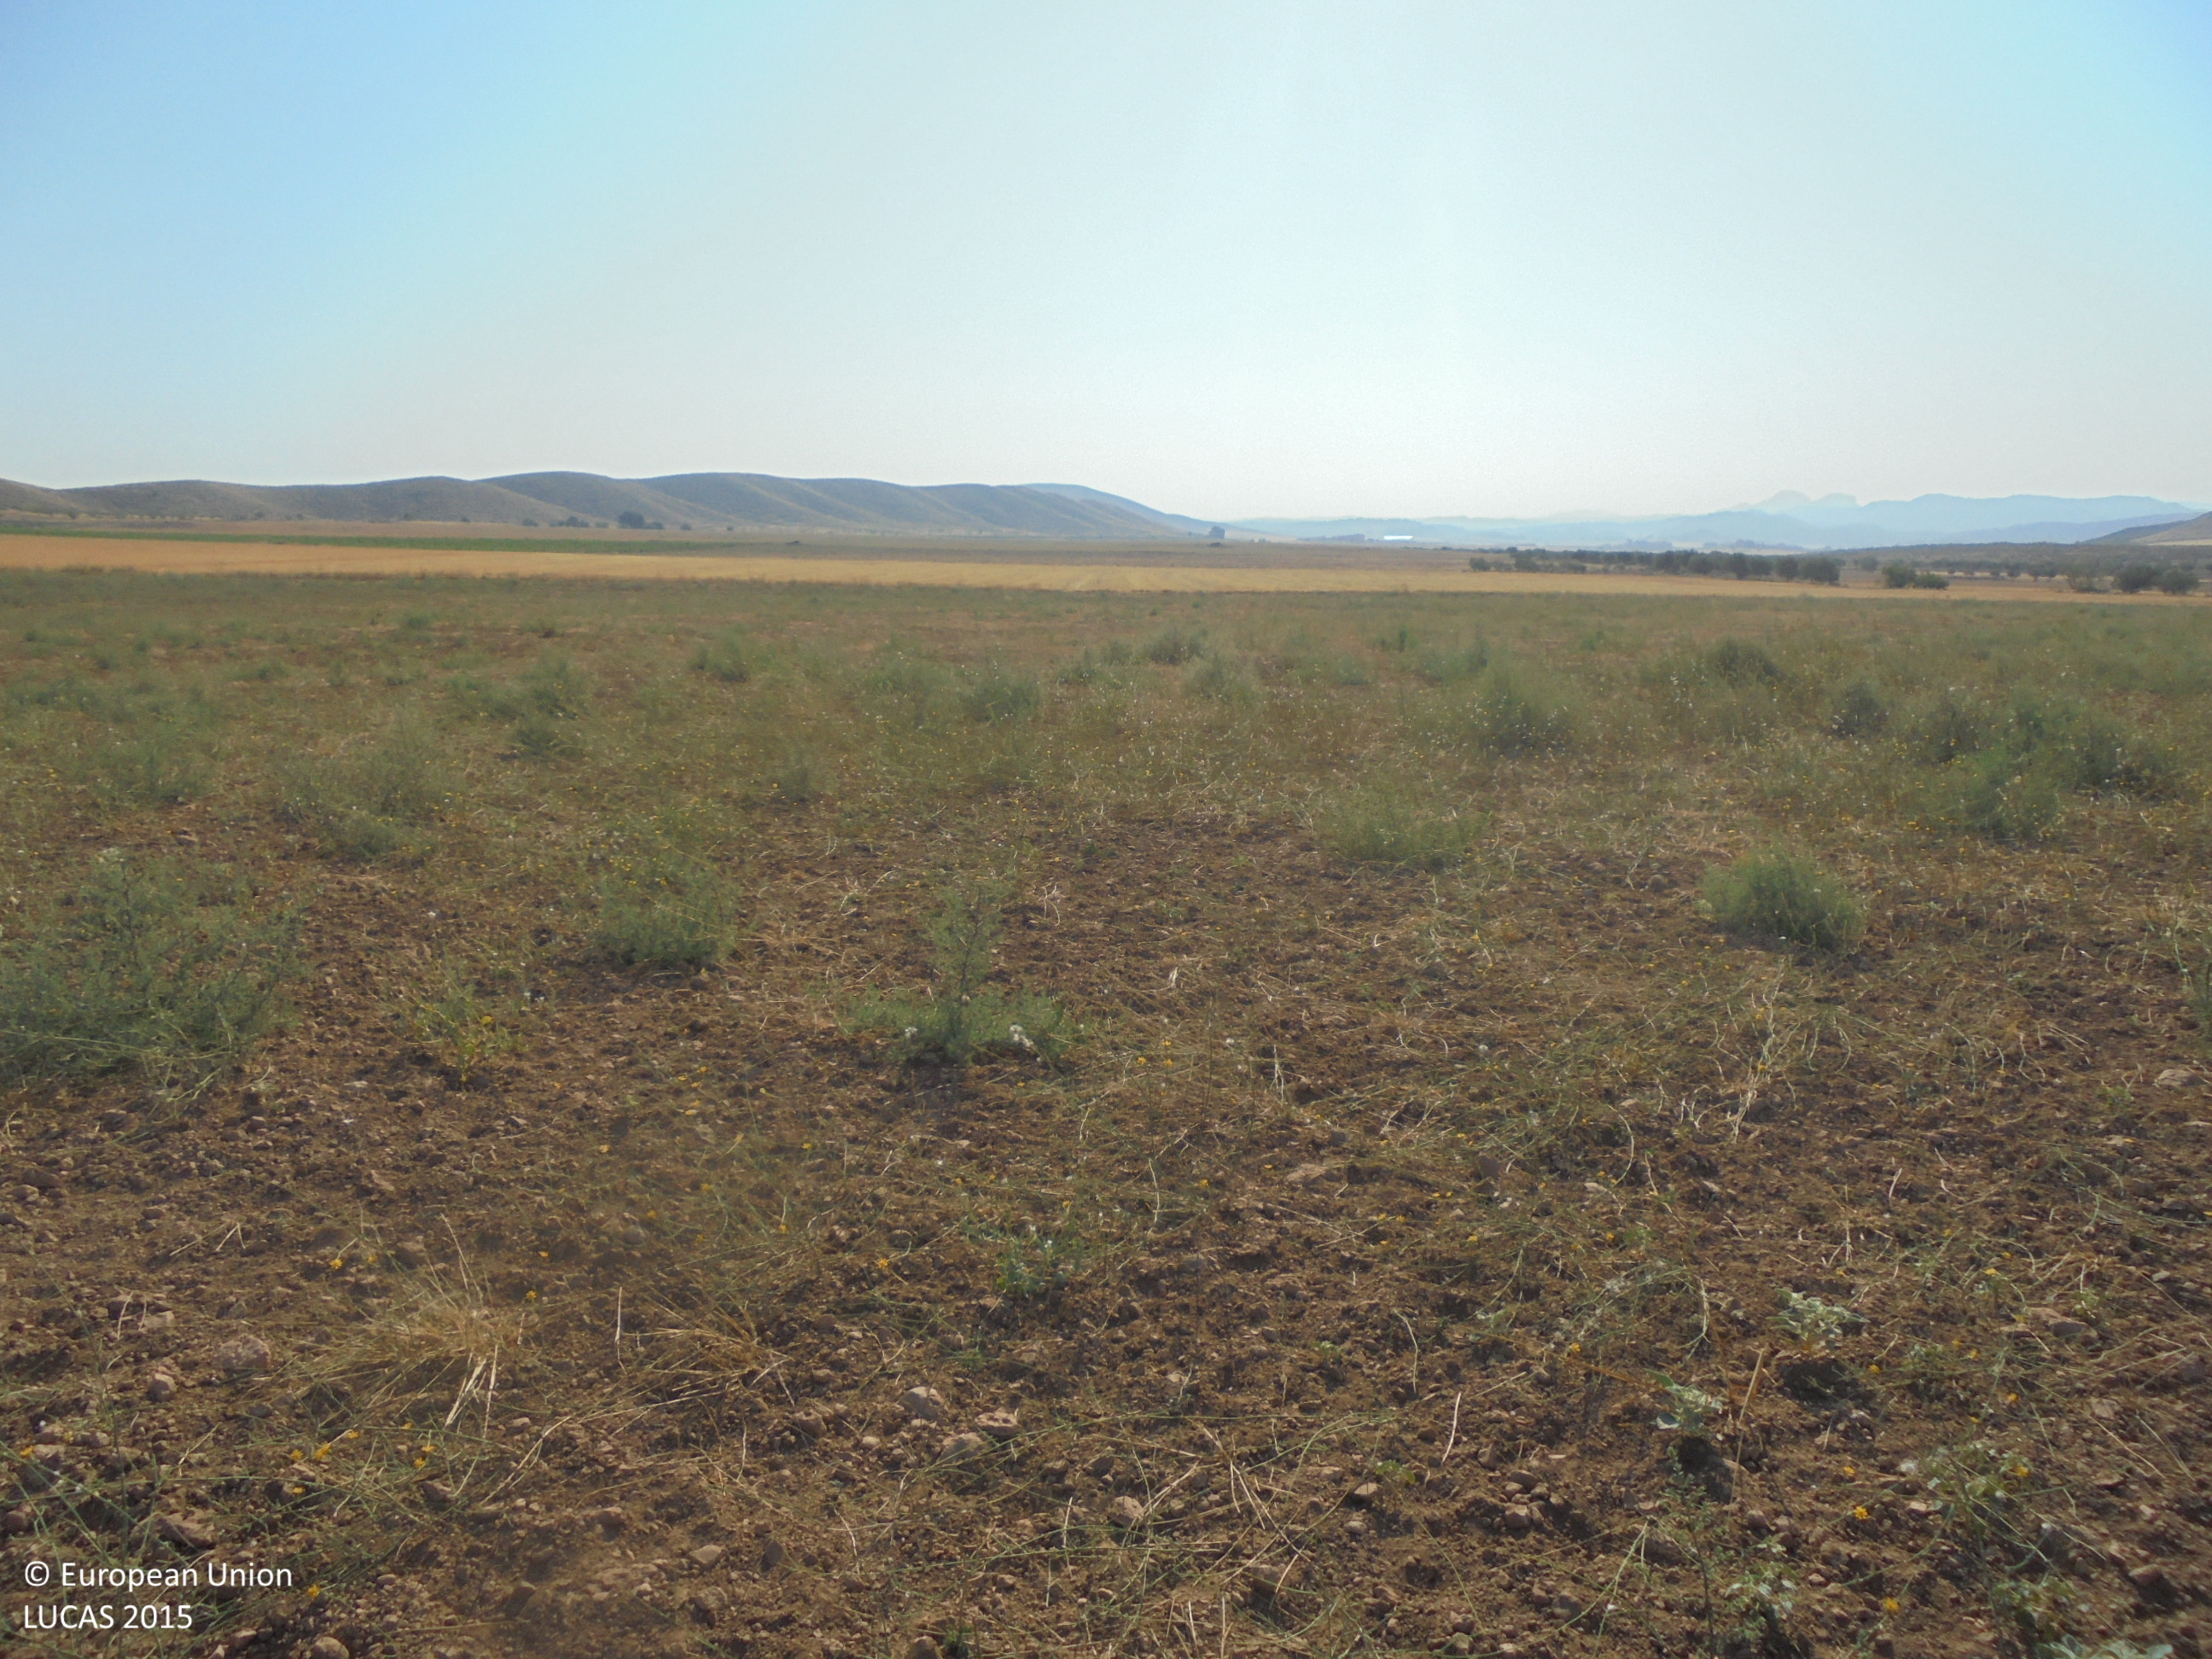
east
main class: Grassland
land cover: Spontaneously vegetated surfaces
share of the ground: 10 - 25 %
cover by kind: unconsolidated bare surface 80 %, herbaceous plants 20 %
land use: Agriculture (excluding fallow land and kitchen gardens)
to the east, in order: Spontaneously vegetated surfaces; Grass margins; Barley
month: July
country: ES
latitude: 38.5102
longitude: -1.6560
